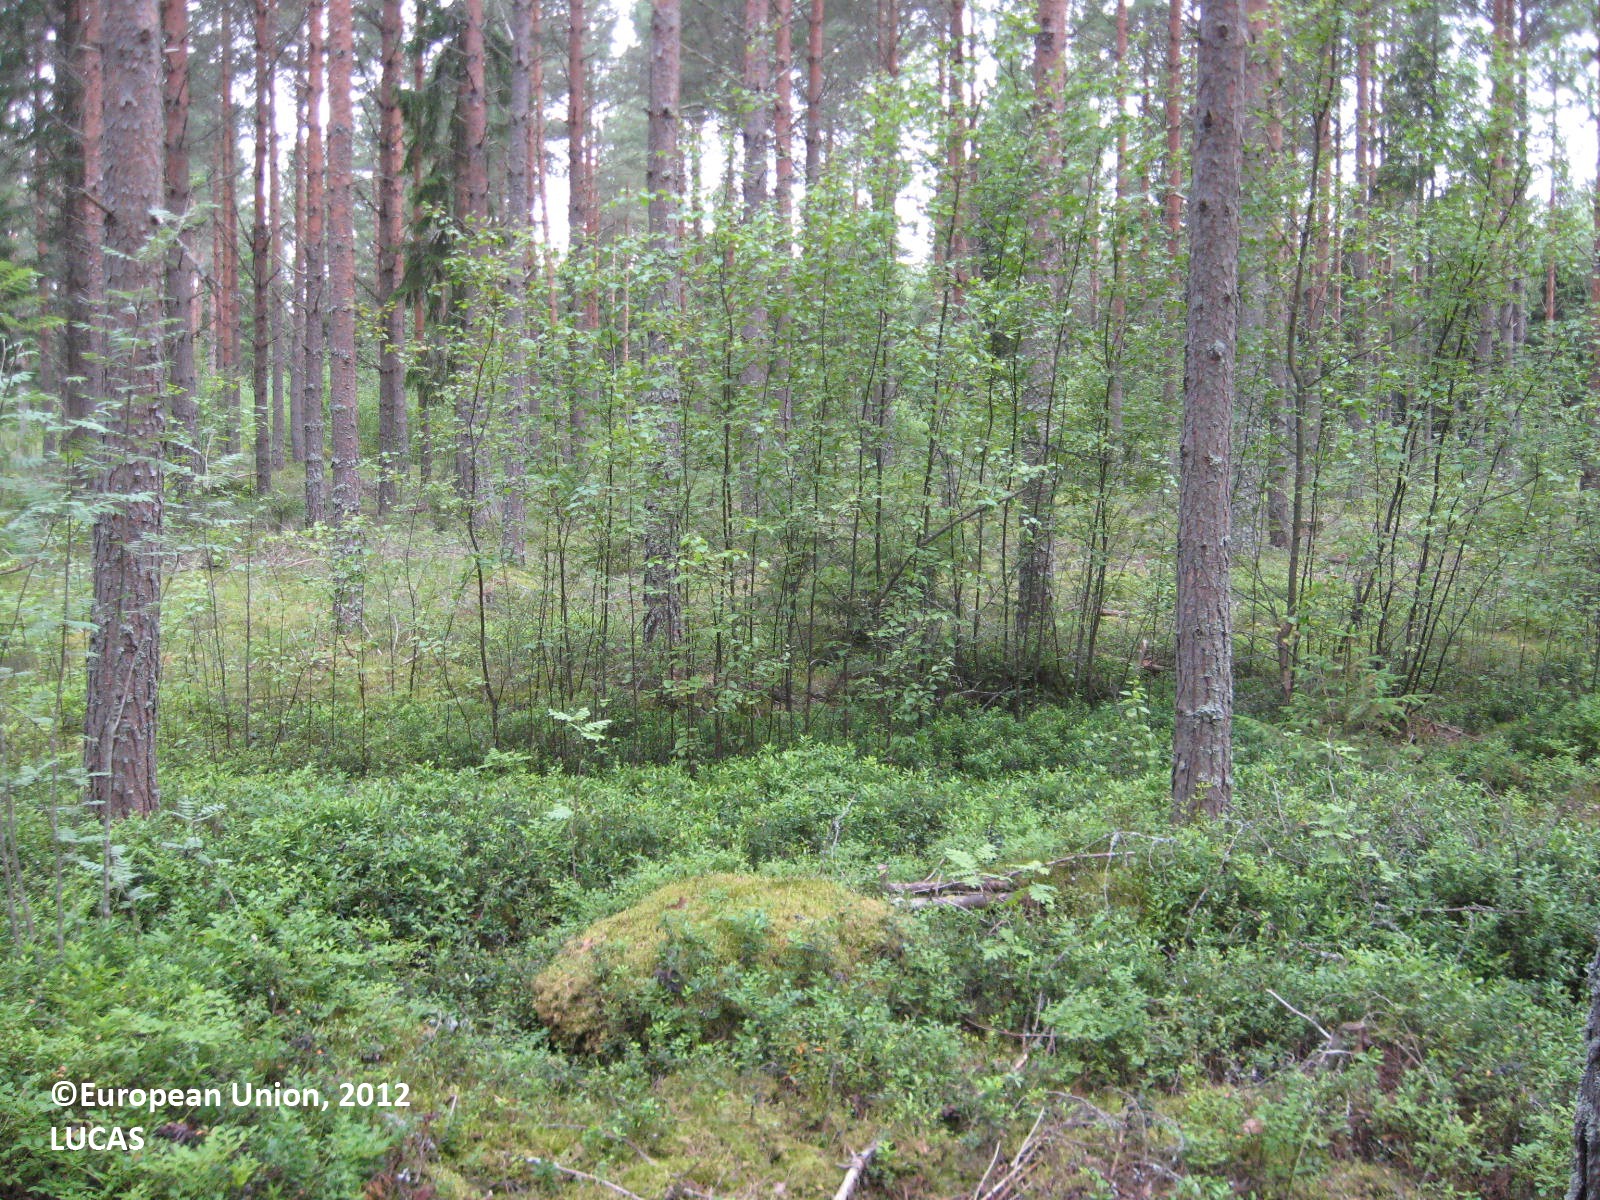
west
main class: Woodland
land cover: Pine dominated coniferous woodland
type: boreal forest
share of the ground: > 75 %
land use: Forestry
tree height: > 5 m
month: July
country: FI
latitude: 62.4854
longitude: 21.1970
